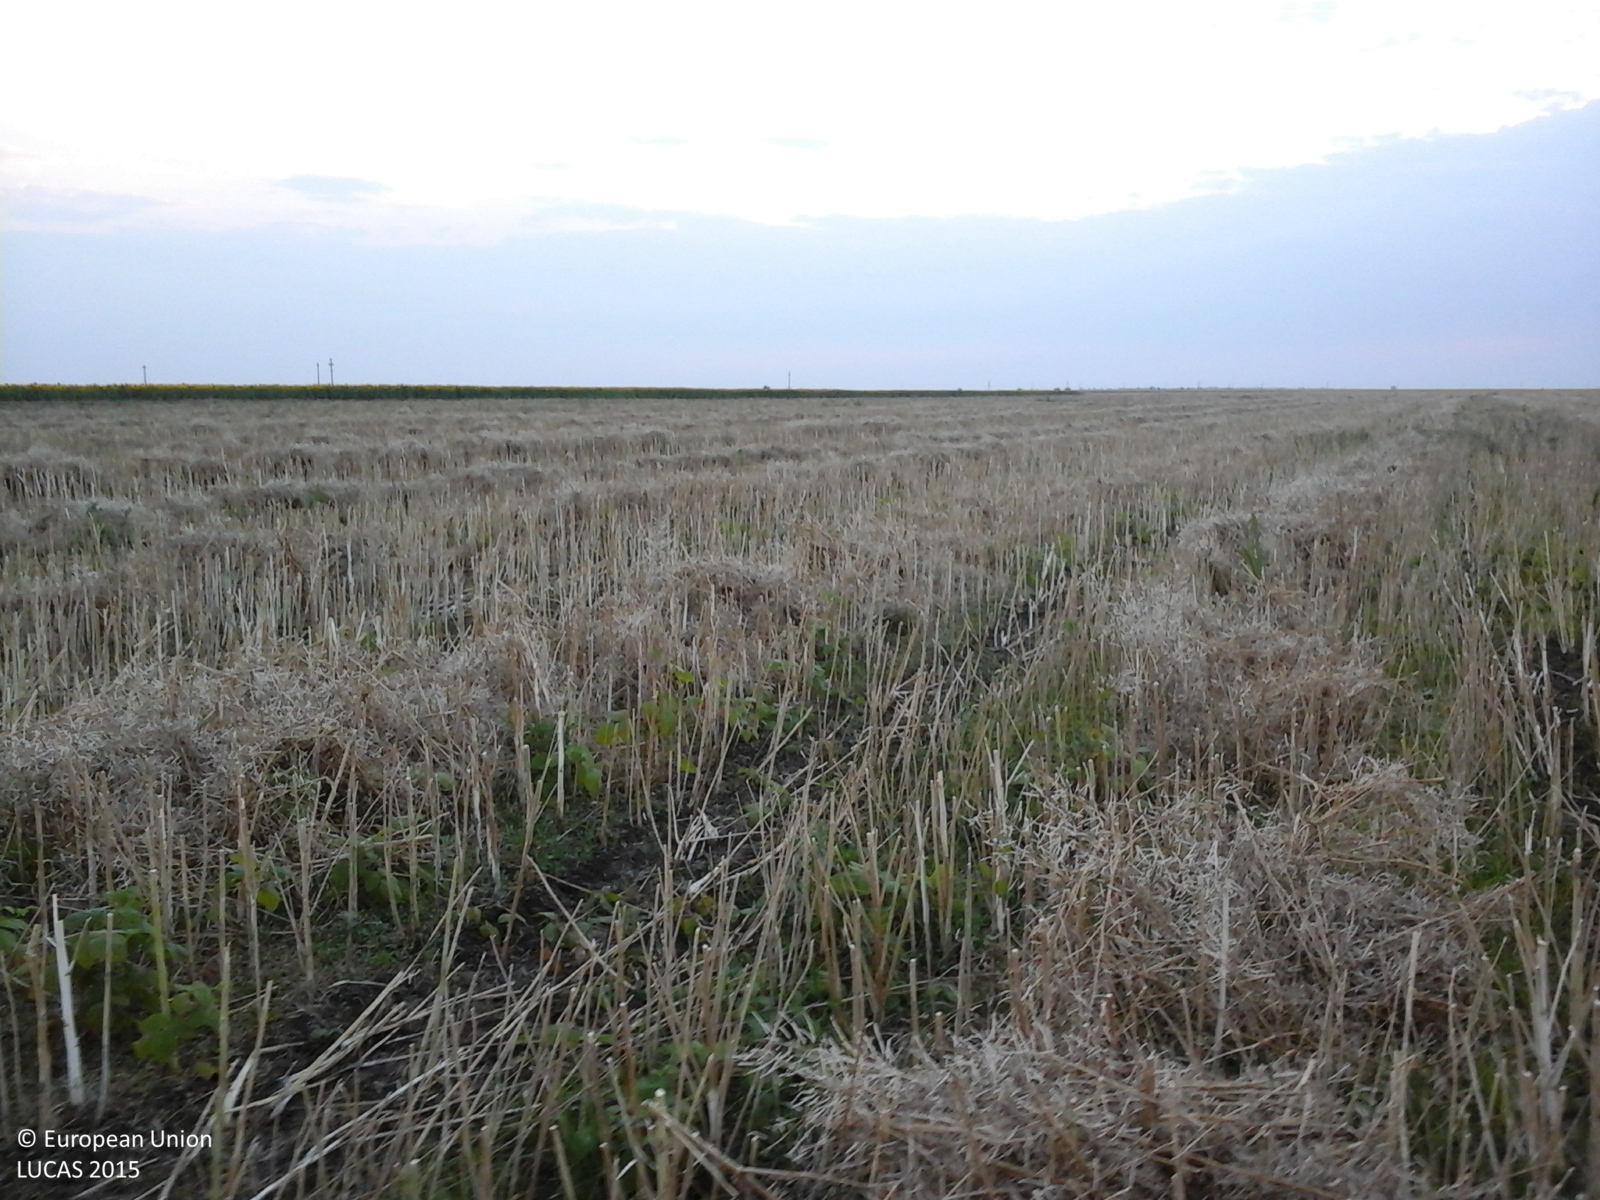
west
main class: Cropland
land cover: Rape and turnip rape
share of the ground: < 10 %
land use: Agriculture (excluding fallow land and kitchen gardens)
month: July
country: RO
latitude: 43.7659
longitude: 25.2464
